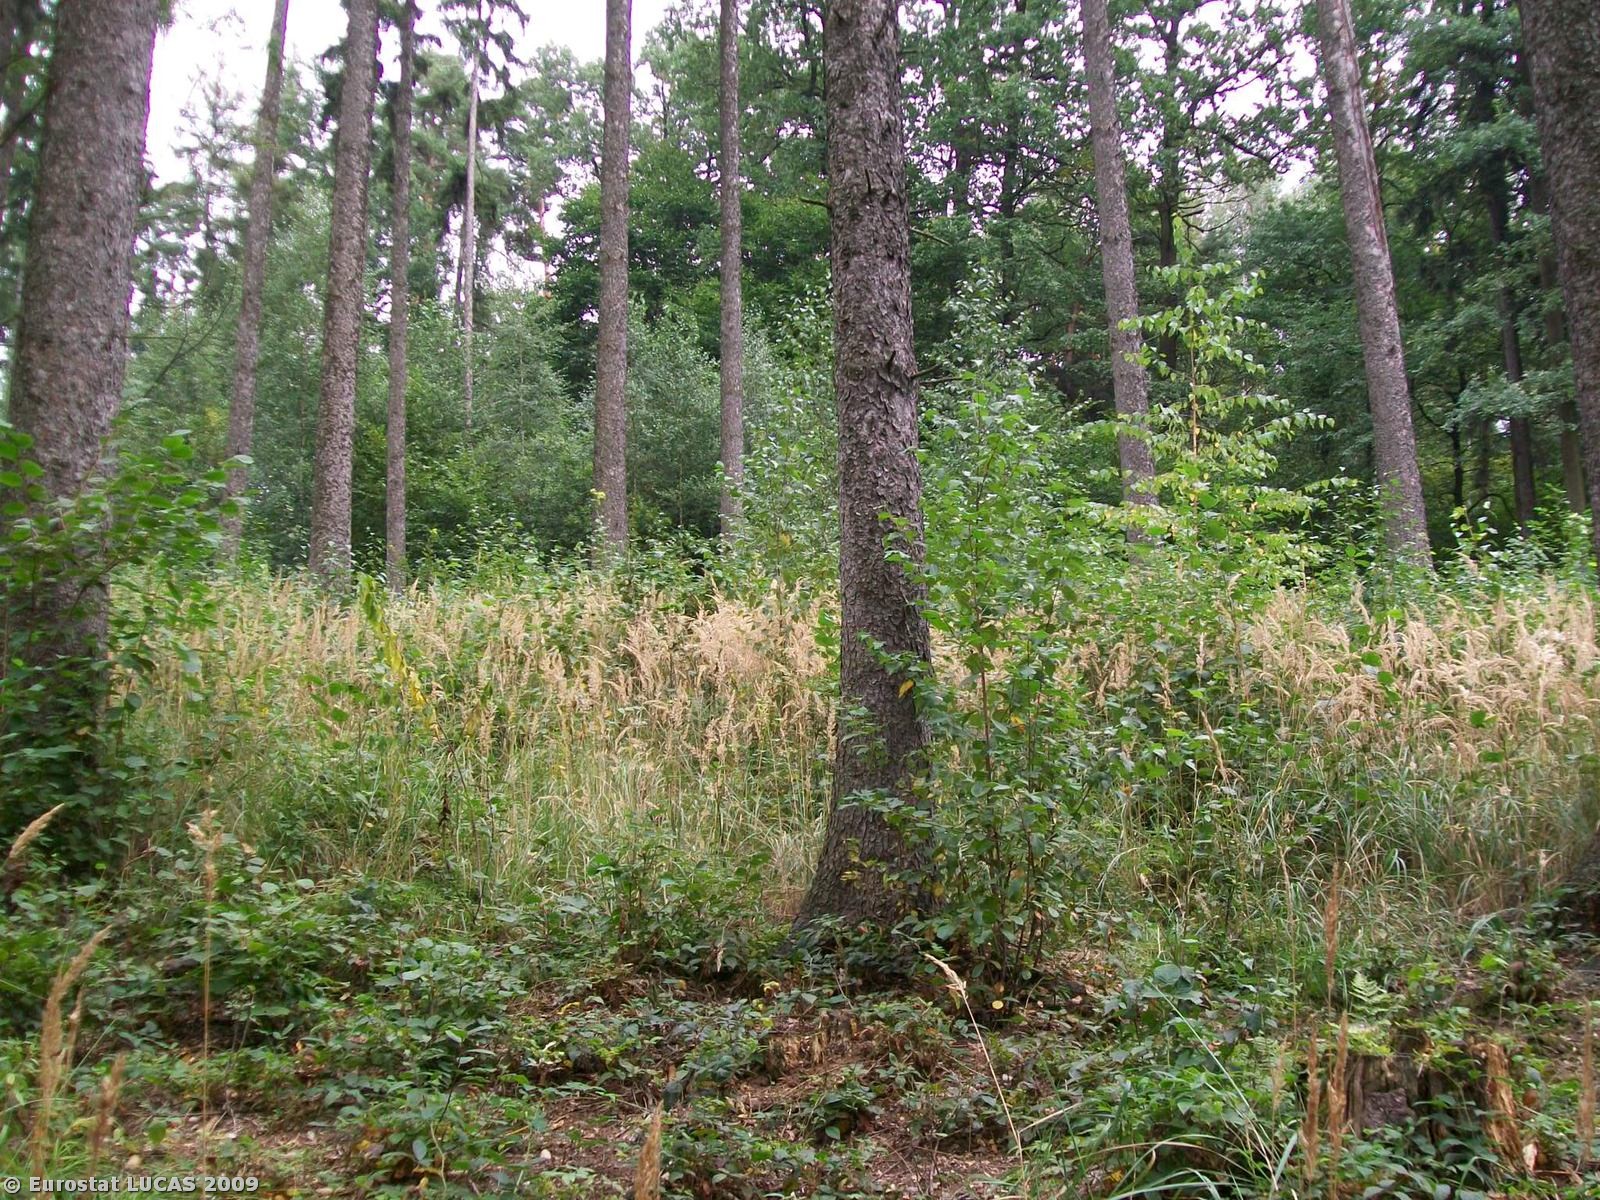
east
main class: Woodland
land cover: Mixed woodland
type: hemiboreal forest and nemoral coniferous forest and mixed broadleaved-coniferous forest
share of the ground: > 75 %
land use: Unused
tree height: > 5 m
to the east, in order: Mixed woodland
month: September
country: PL
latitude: 50.4025
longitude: 17.2853
